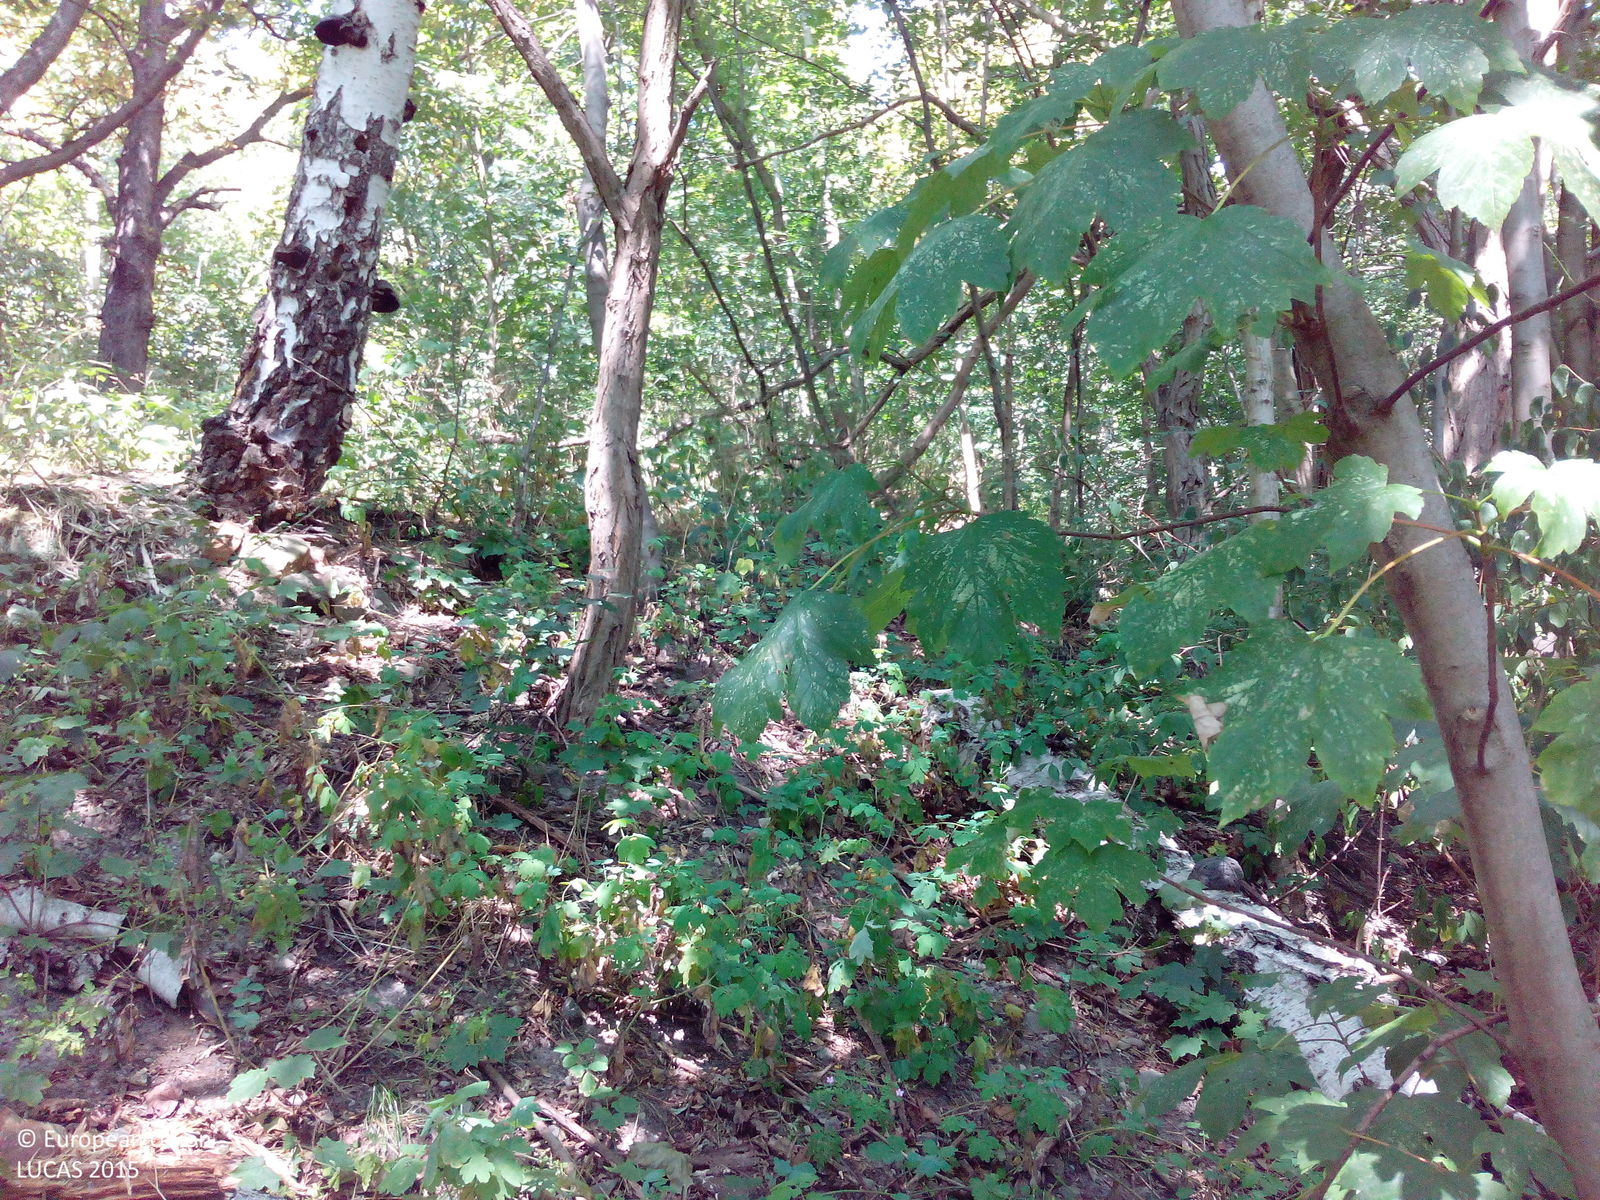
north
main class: Woodland
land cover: Broadleaved woodland
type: mesophytic deciduous forest
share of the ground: > 75 %
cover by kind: broadleaved forest trees 95 %, unconsolidated bare surface 5 %
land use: Forestry
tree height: > 5 m
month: August
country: DE
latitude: 51.8697
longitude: 11.0309
